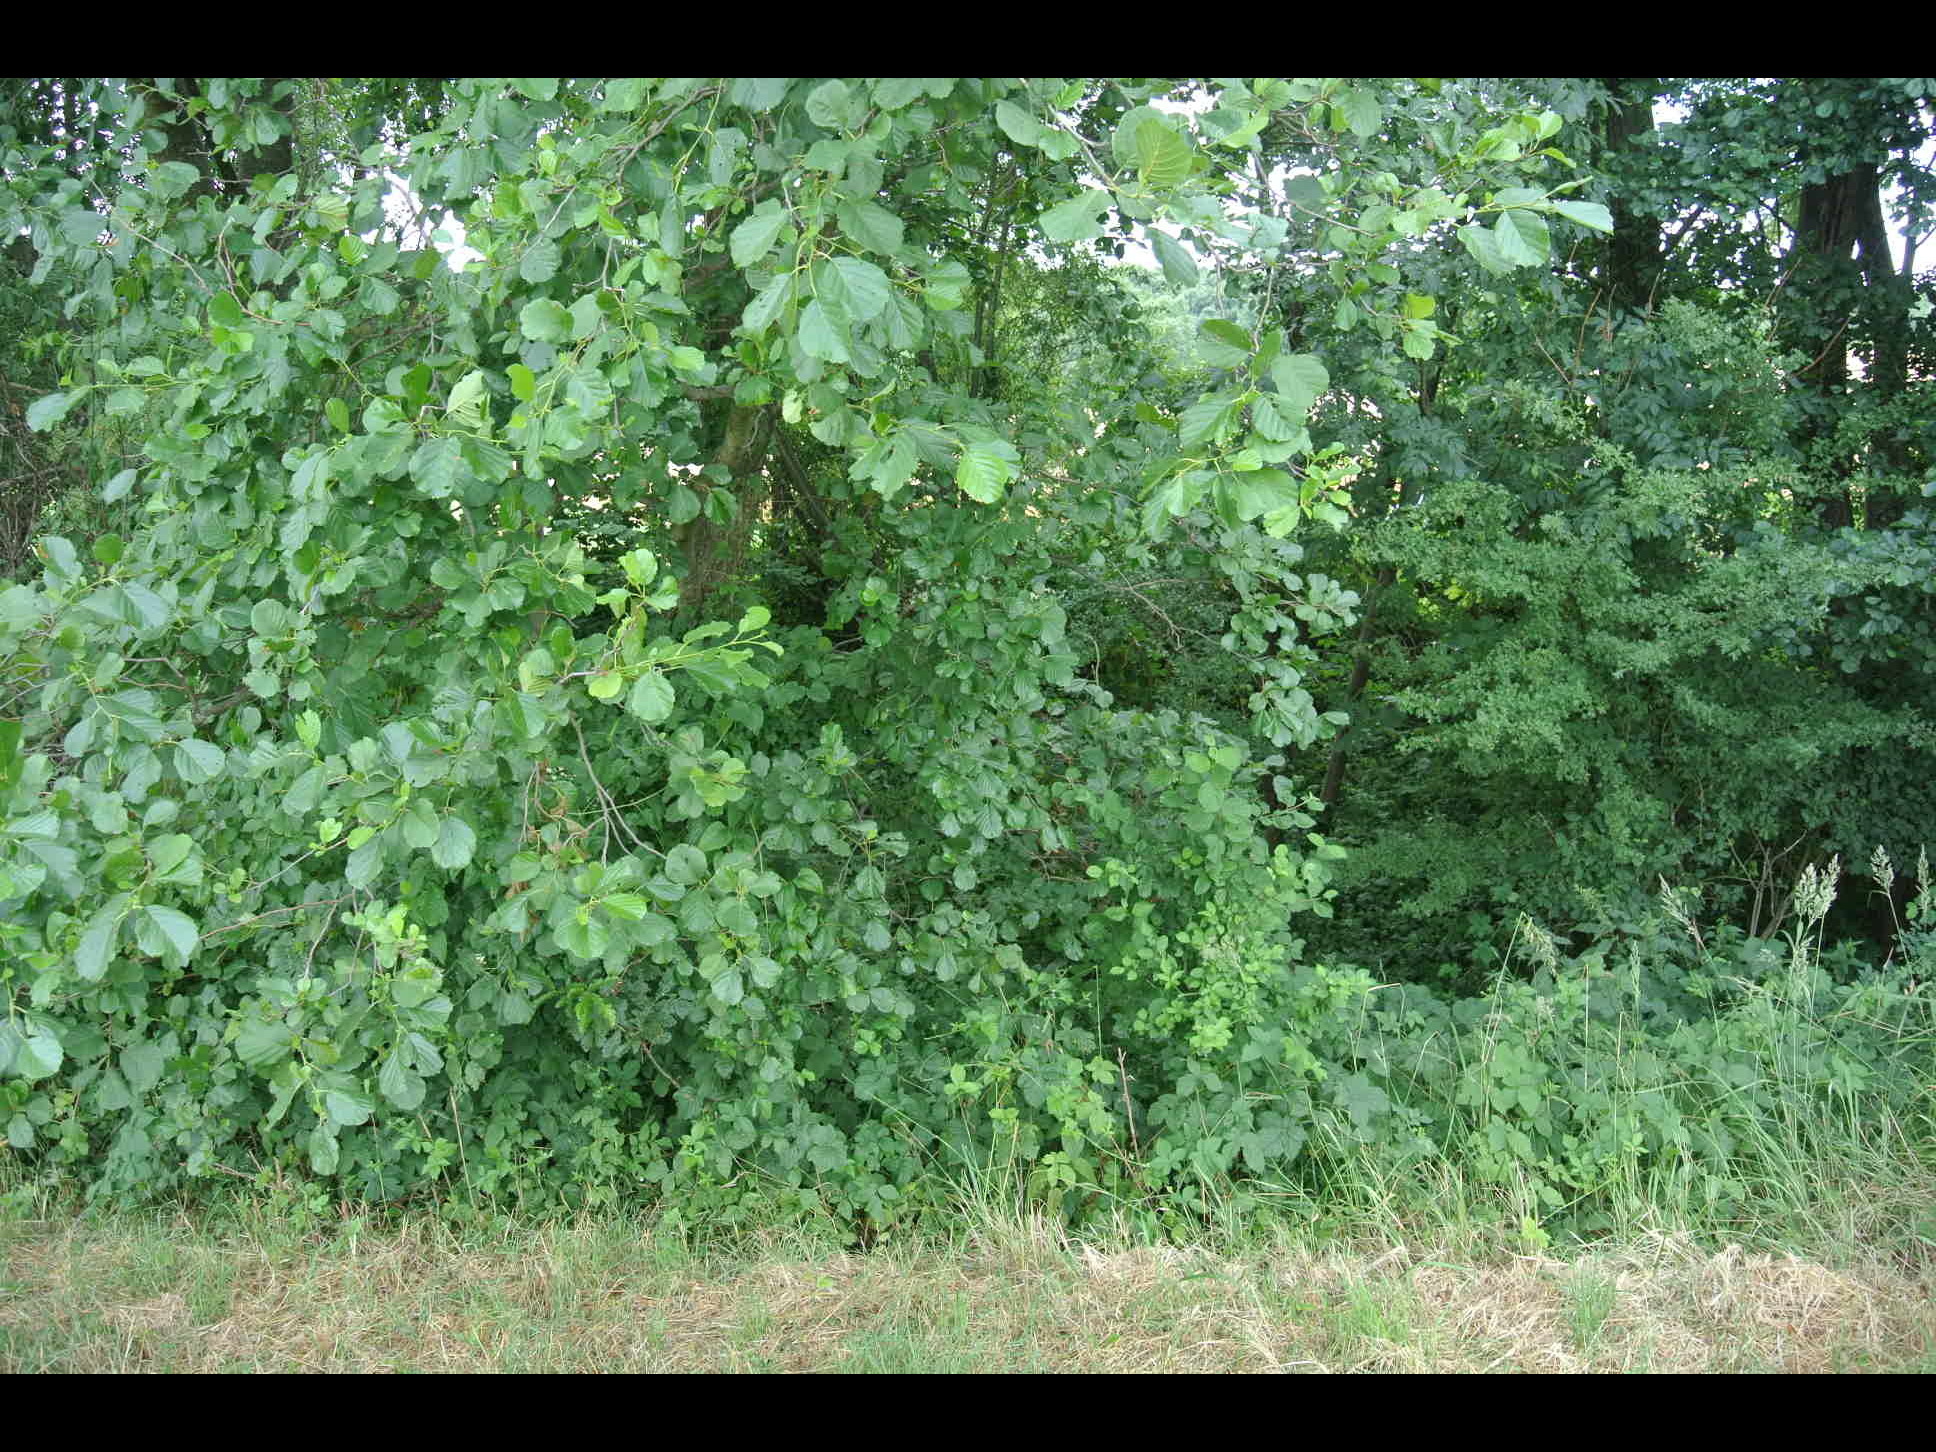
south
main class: Grassland
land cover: Grassland without tree/shrub cover
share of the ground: > 75 %
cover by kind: herbaceous plants 100 %
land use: Agriculture (excluding fallow land and kitchen gardens)
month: July
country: AT
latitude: 47.5684
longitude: 16.3973
